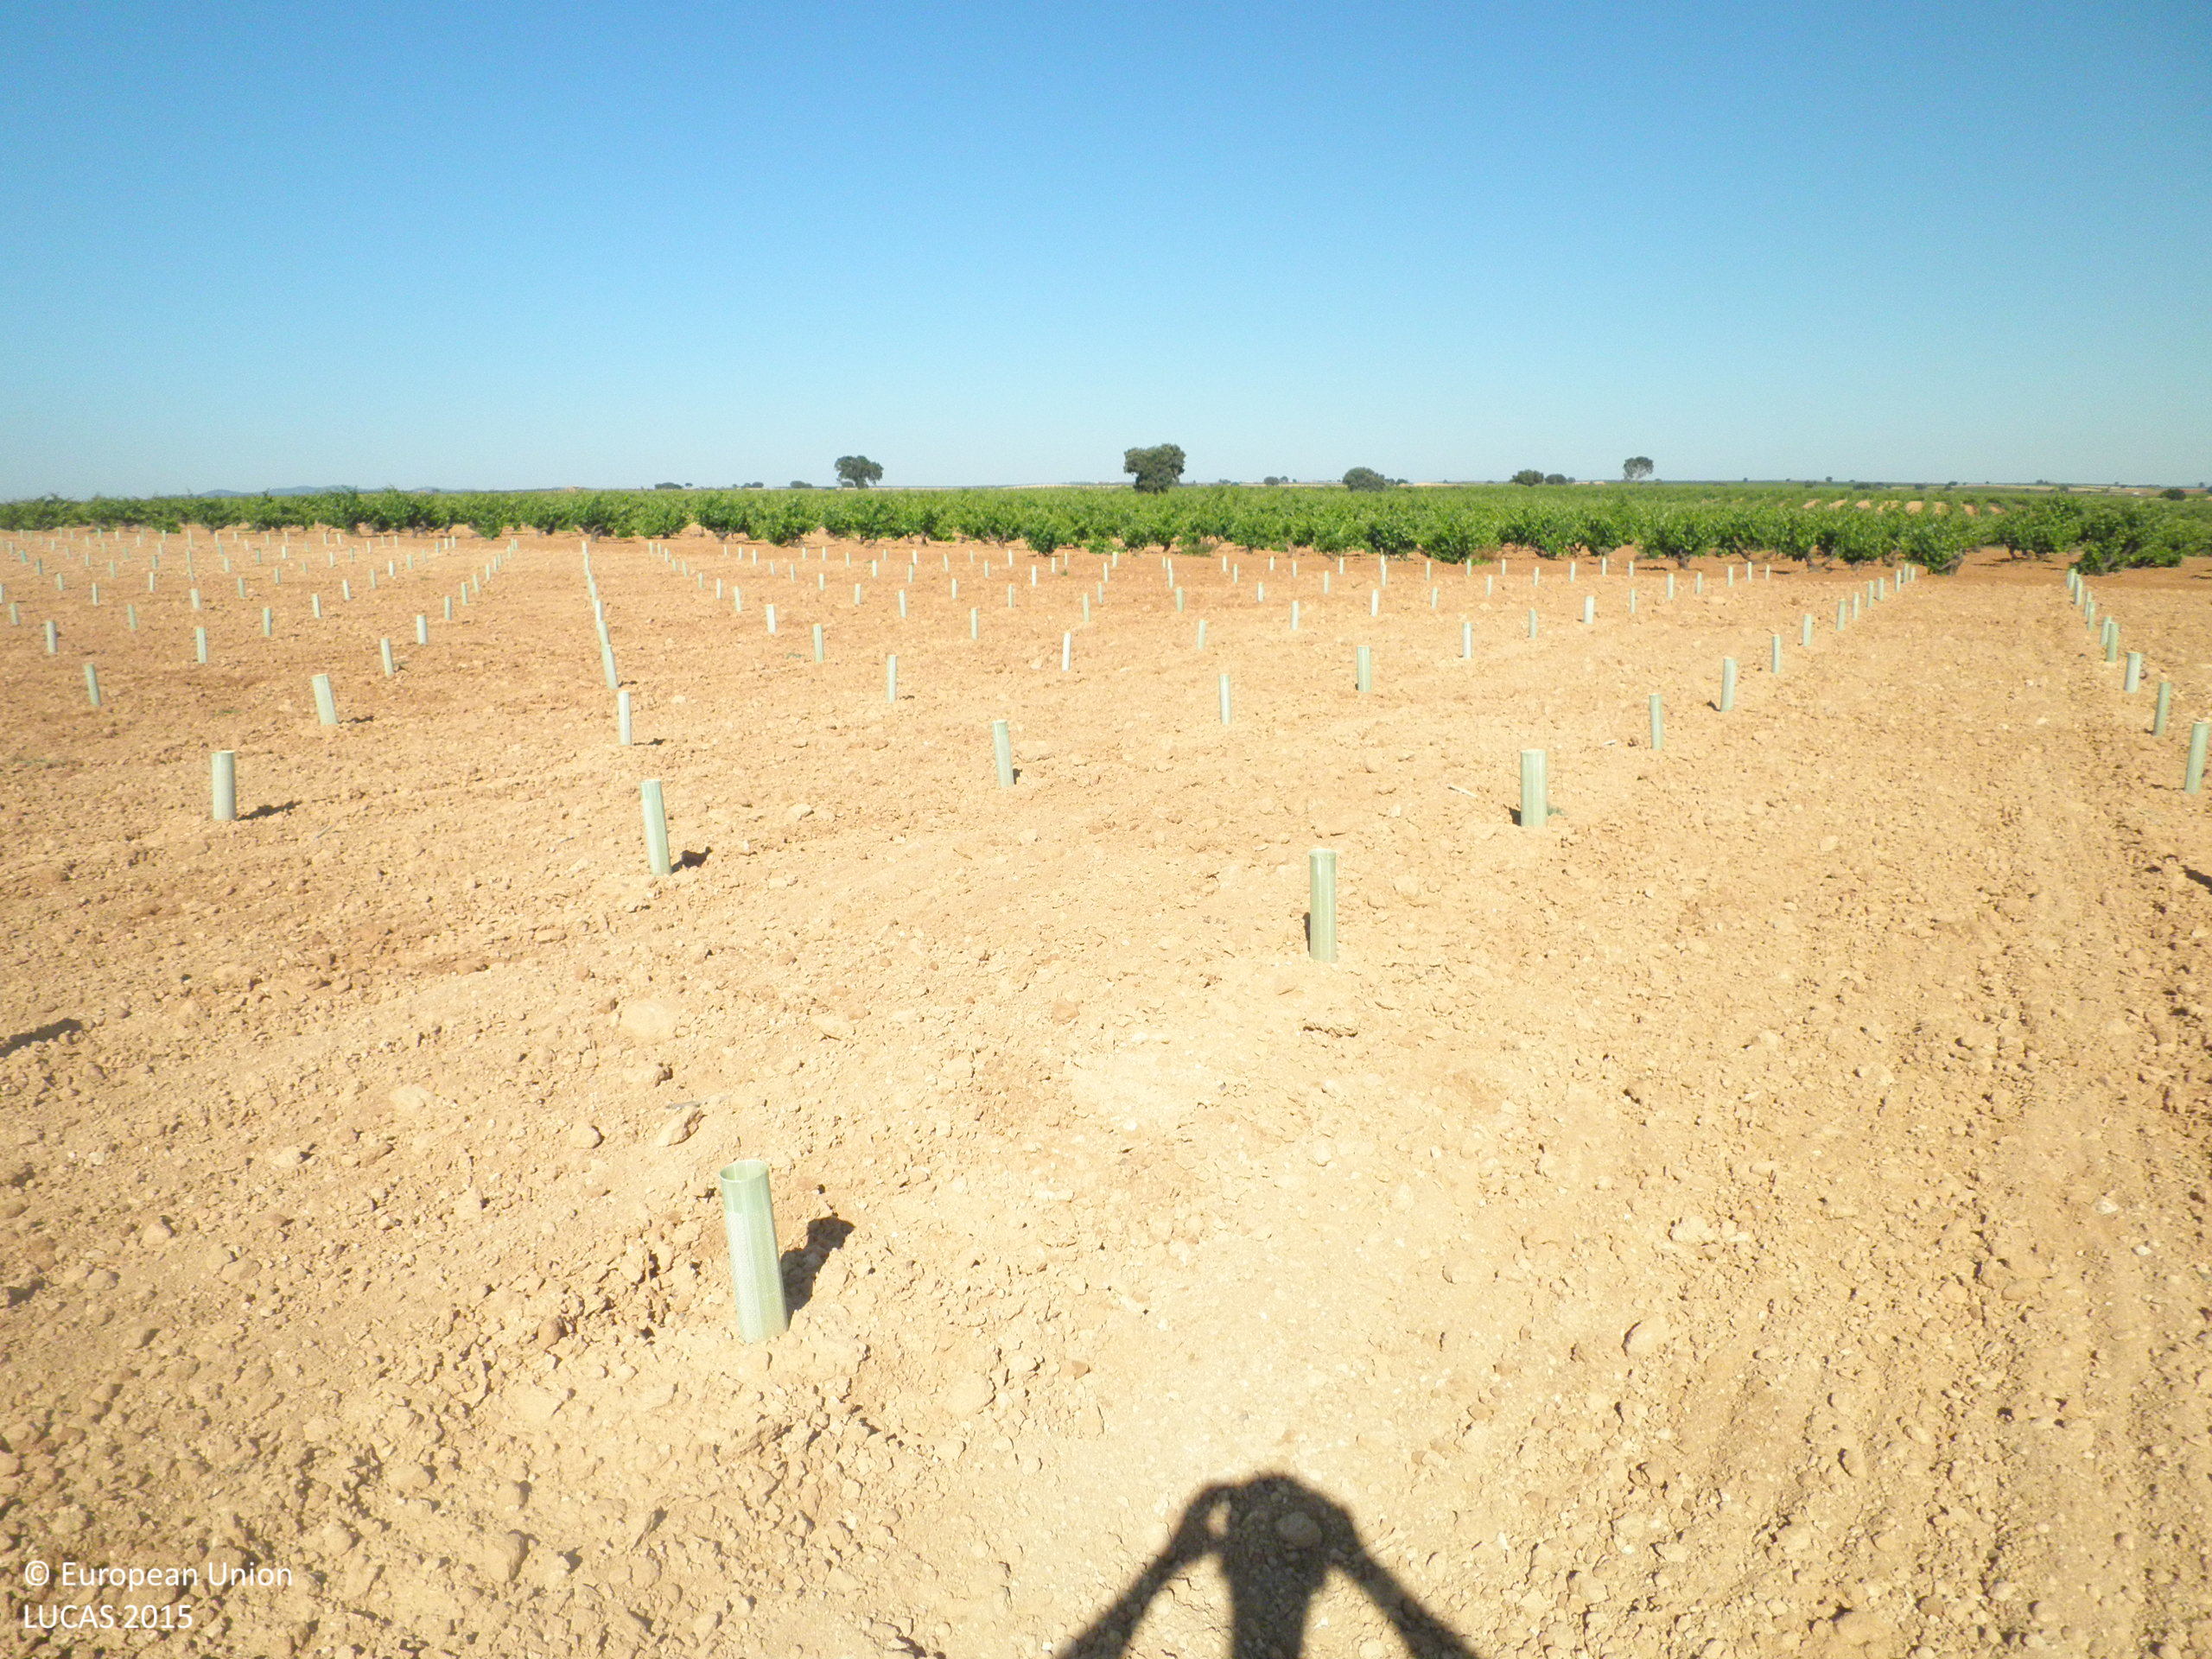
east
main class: Cropland
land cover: Vineyards
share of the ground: < 10 %
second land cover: Other bare soil
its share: > 75 %
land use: Agriculture (excluding fallow land and kitchen gardens)
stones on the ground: < 10 %
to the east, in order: Vineyards; Other bare soil; Tracks; Single bushes/trees; Tracks; Vineyards; Tracks; Grass margins; Vineyards; Tracks; Grass margins; Vineyards
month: June
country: ES
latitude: 39.4033
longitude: -1.6751
